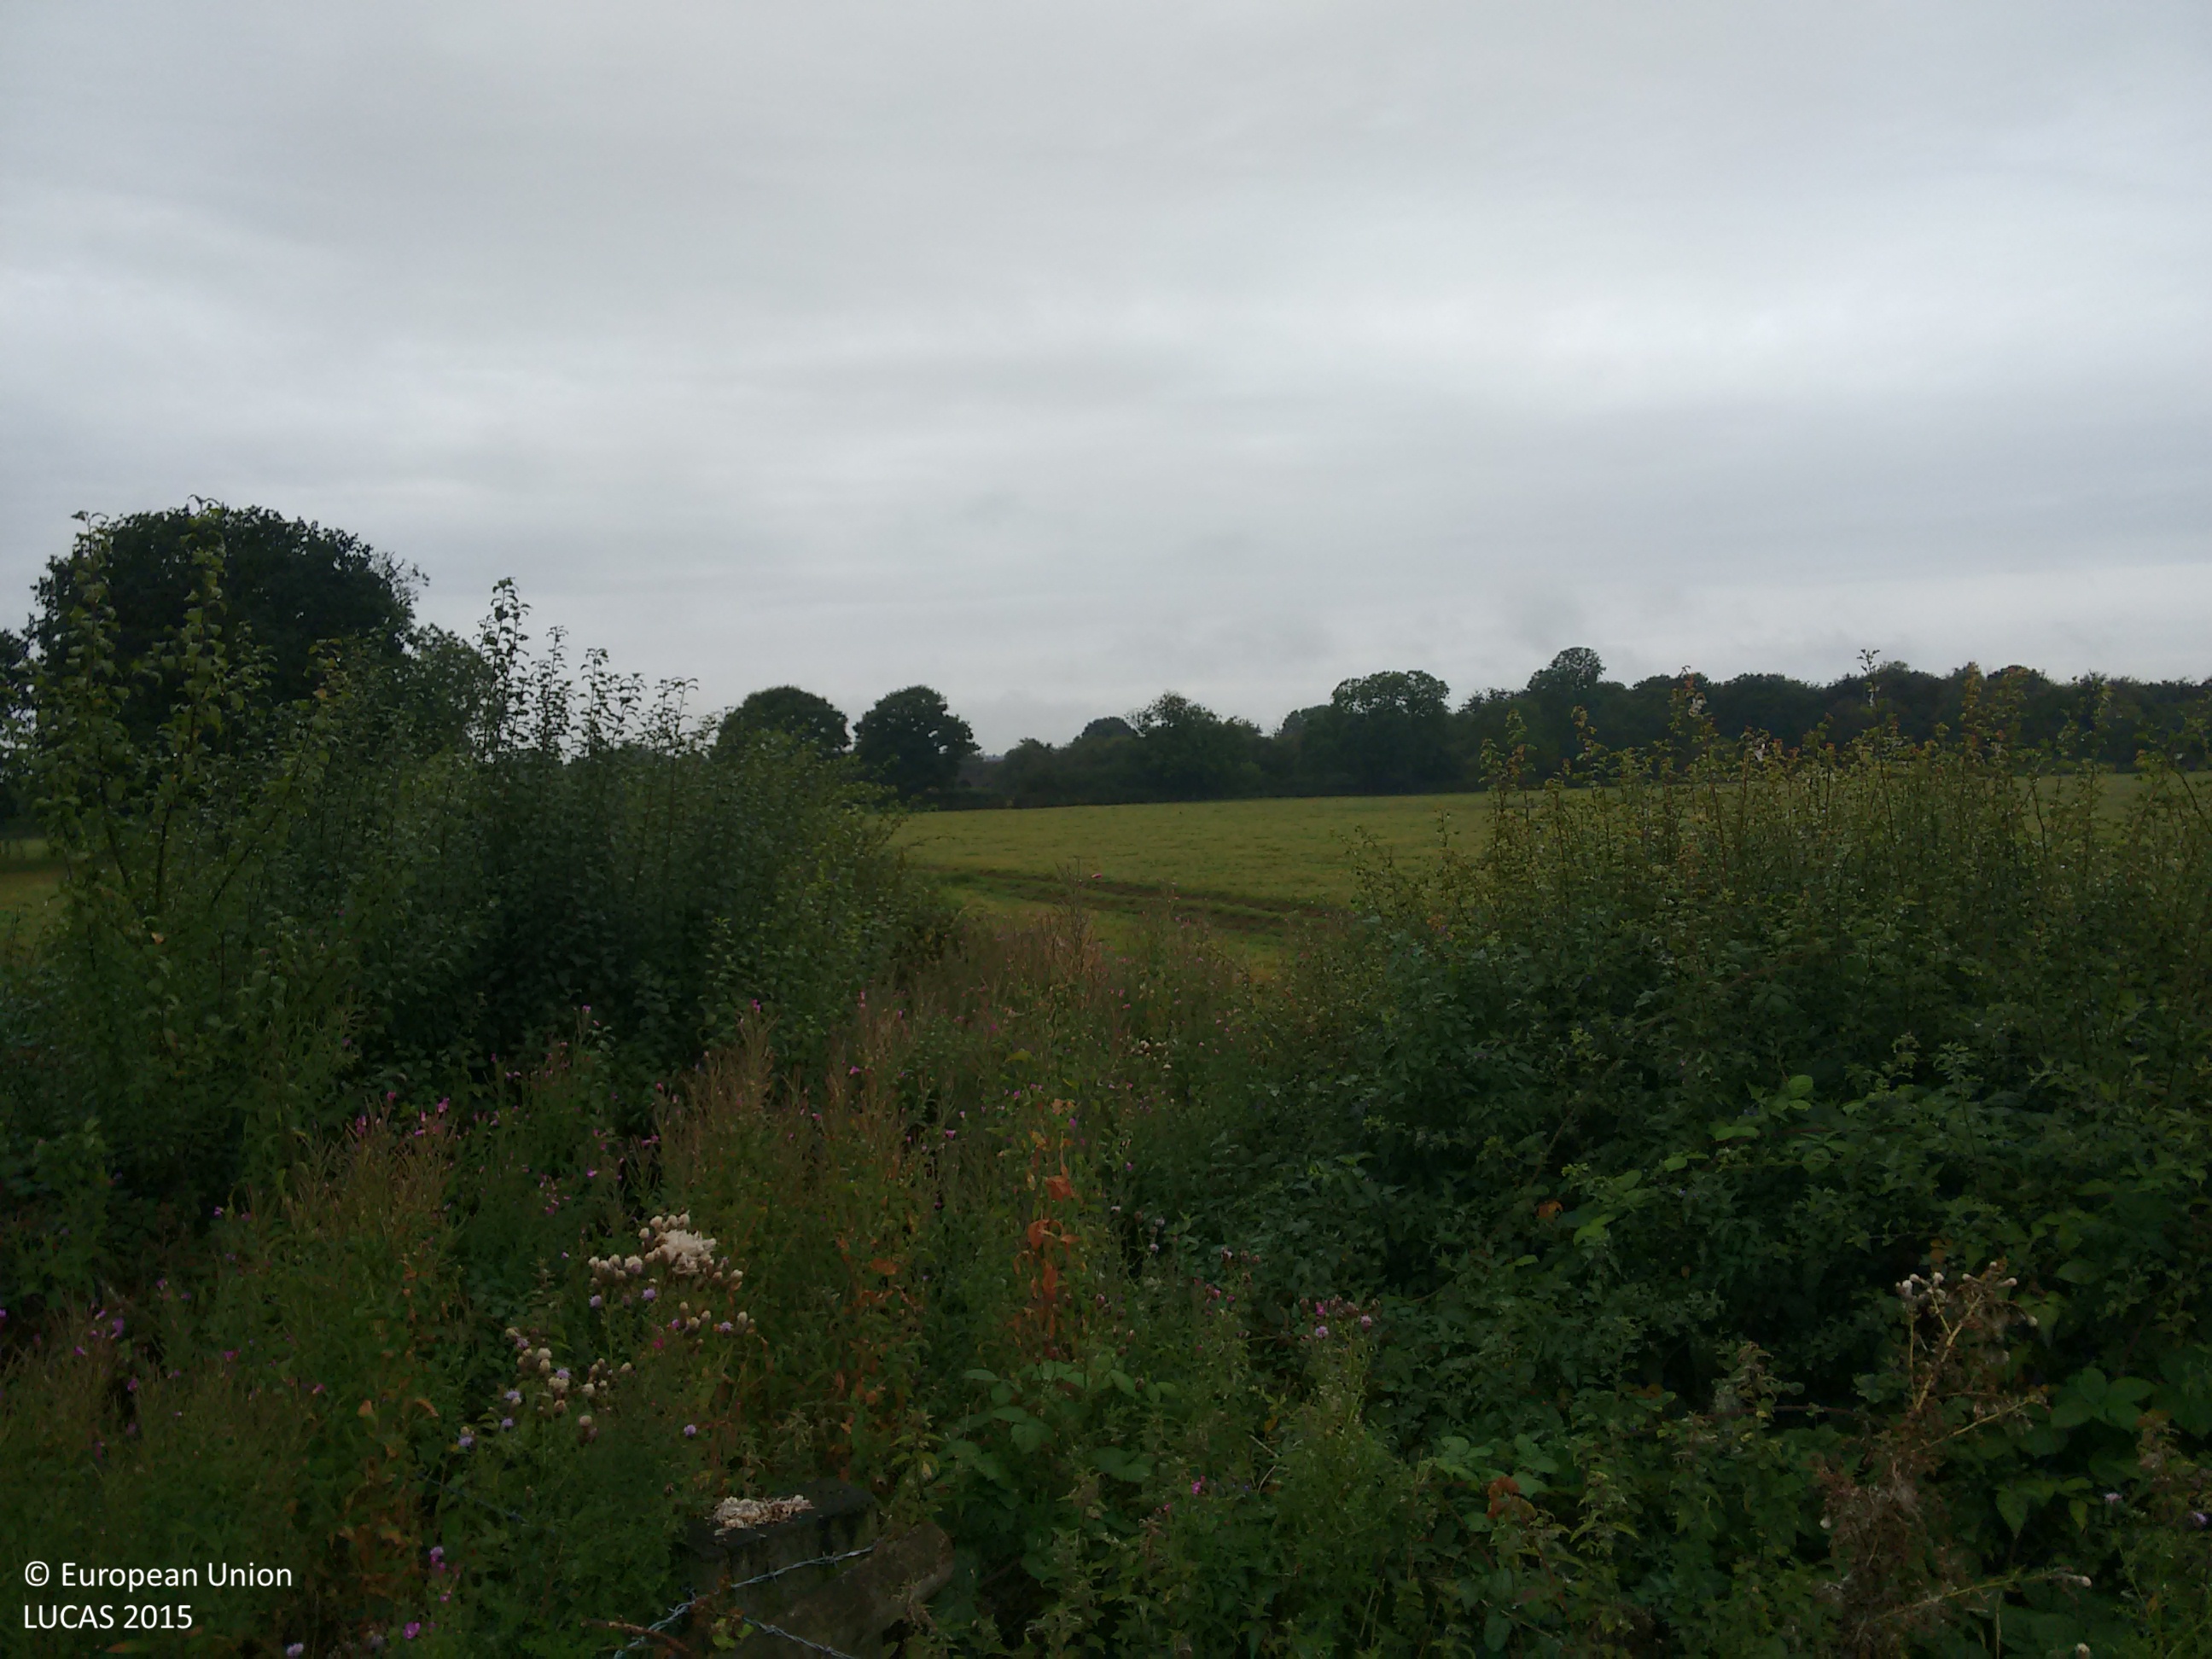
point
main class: Grassland
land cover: Grassland without tree/shrub cover
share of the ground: > 75 %
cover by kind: herbaceous plants 100 %
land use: Agriculture (excluding fallow land and kitchen gardens)
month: August
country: GB
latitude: 52.0901
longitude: -1.3012
